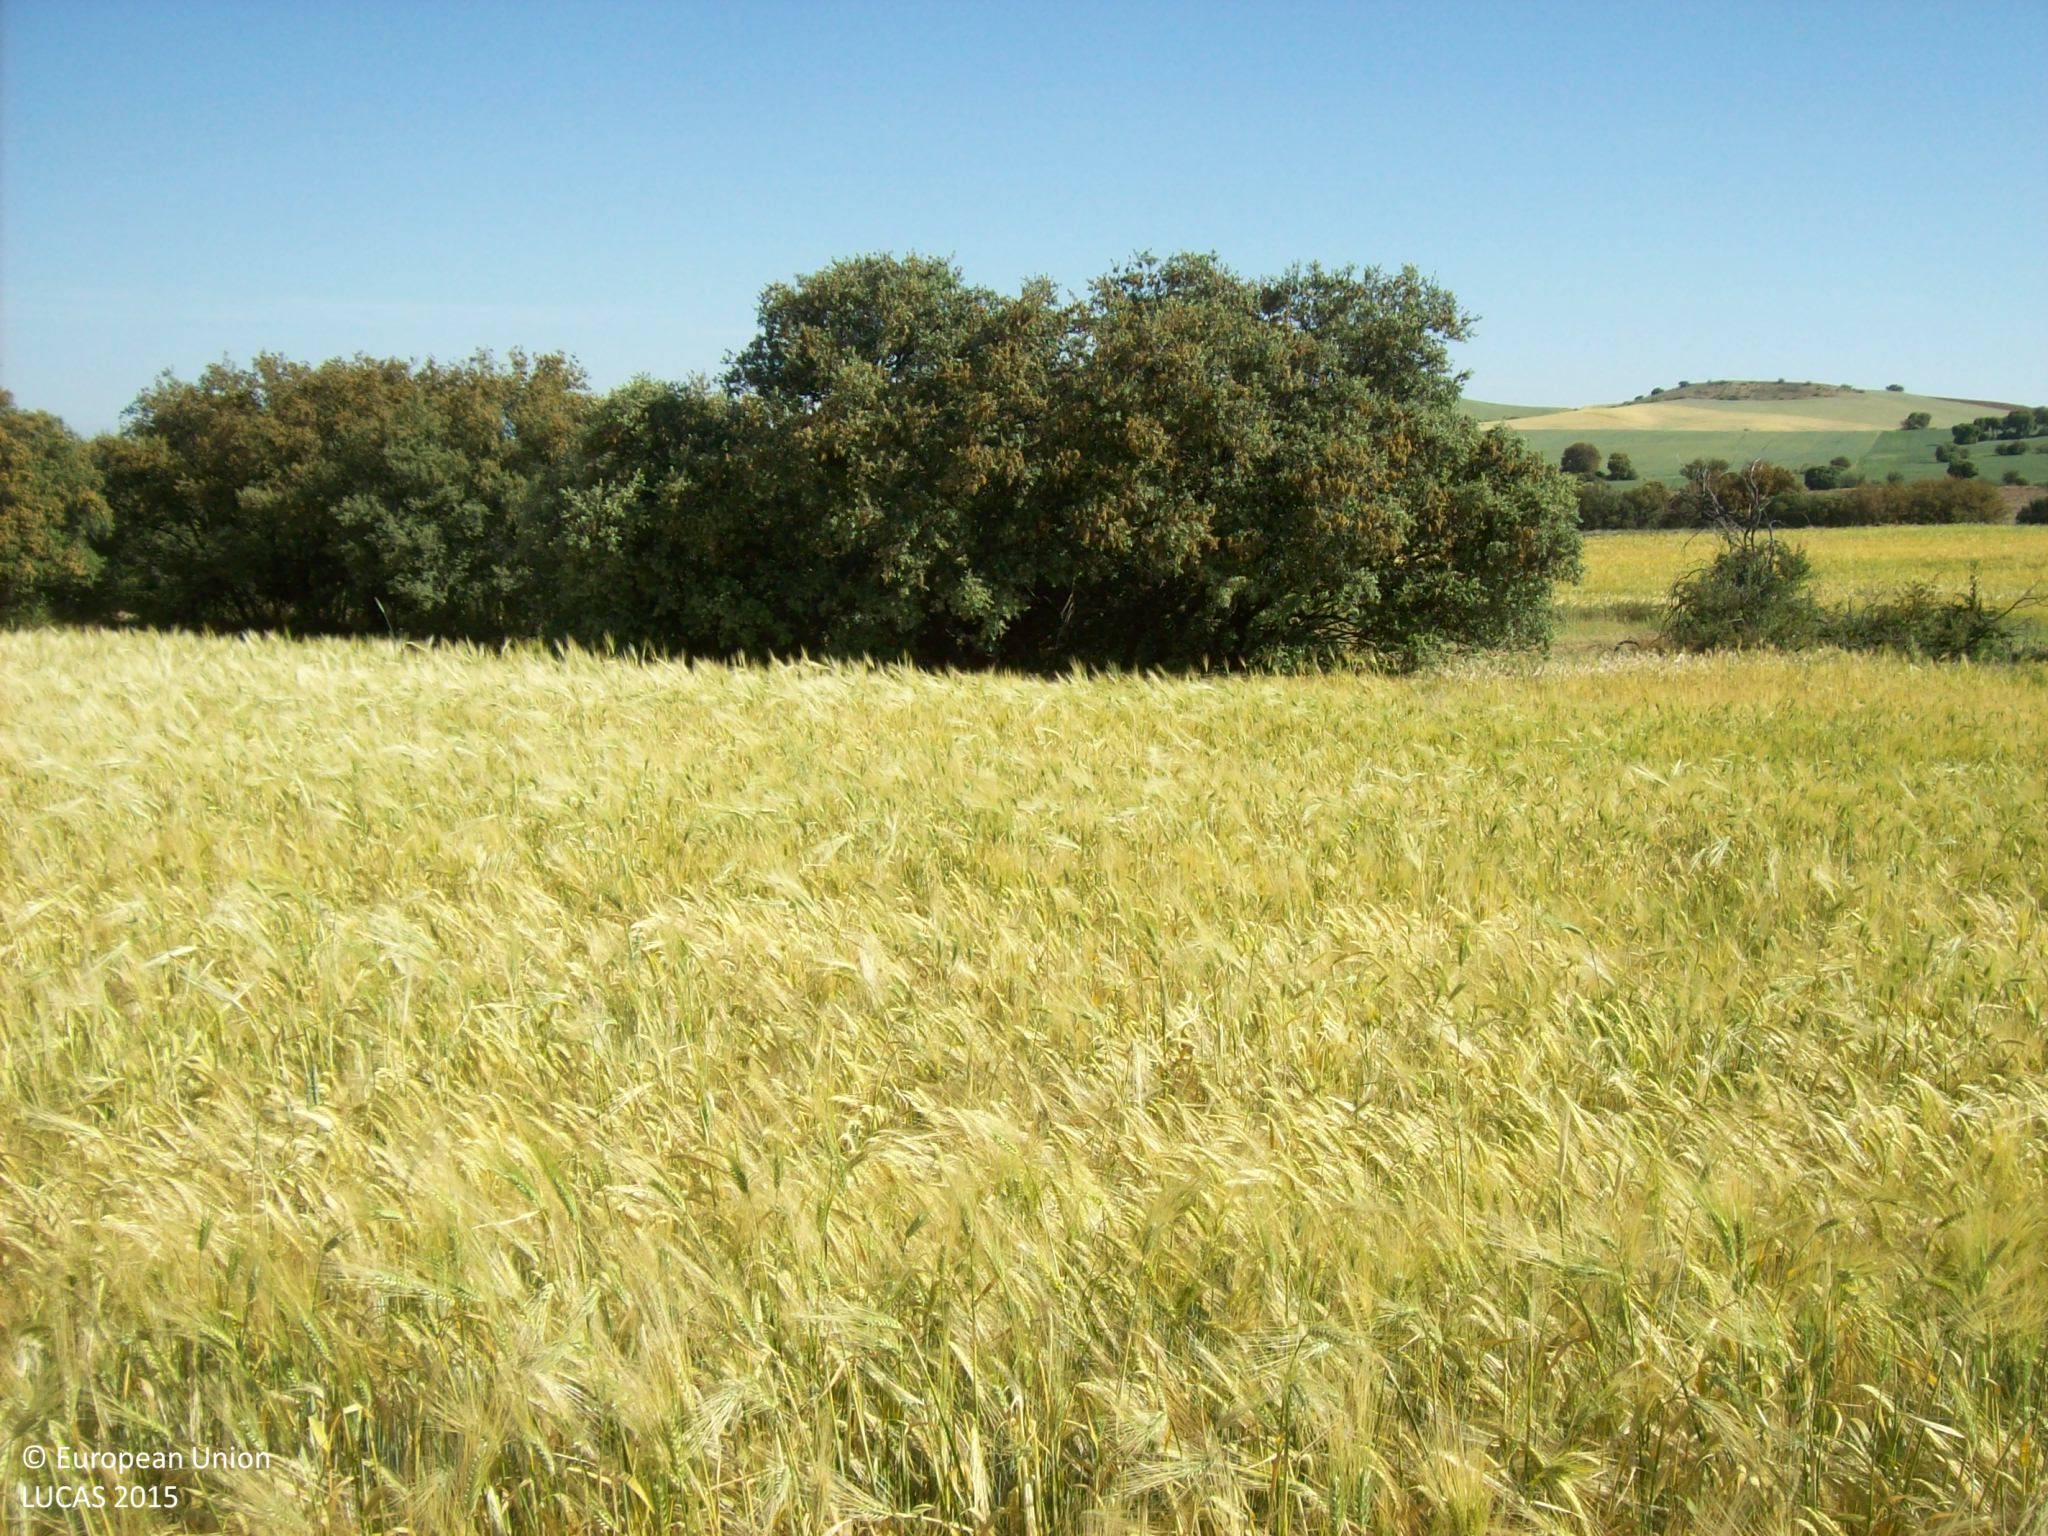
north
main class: Cropland
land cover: Barley
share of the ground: > 75 %
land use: Agriculture (excluding fallow land and kitchen gardens)
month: May
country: ES
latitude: 40.9782
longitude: -4.5205
